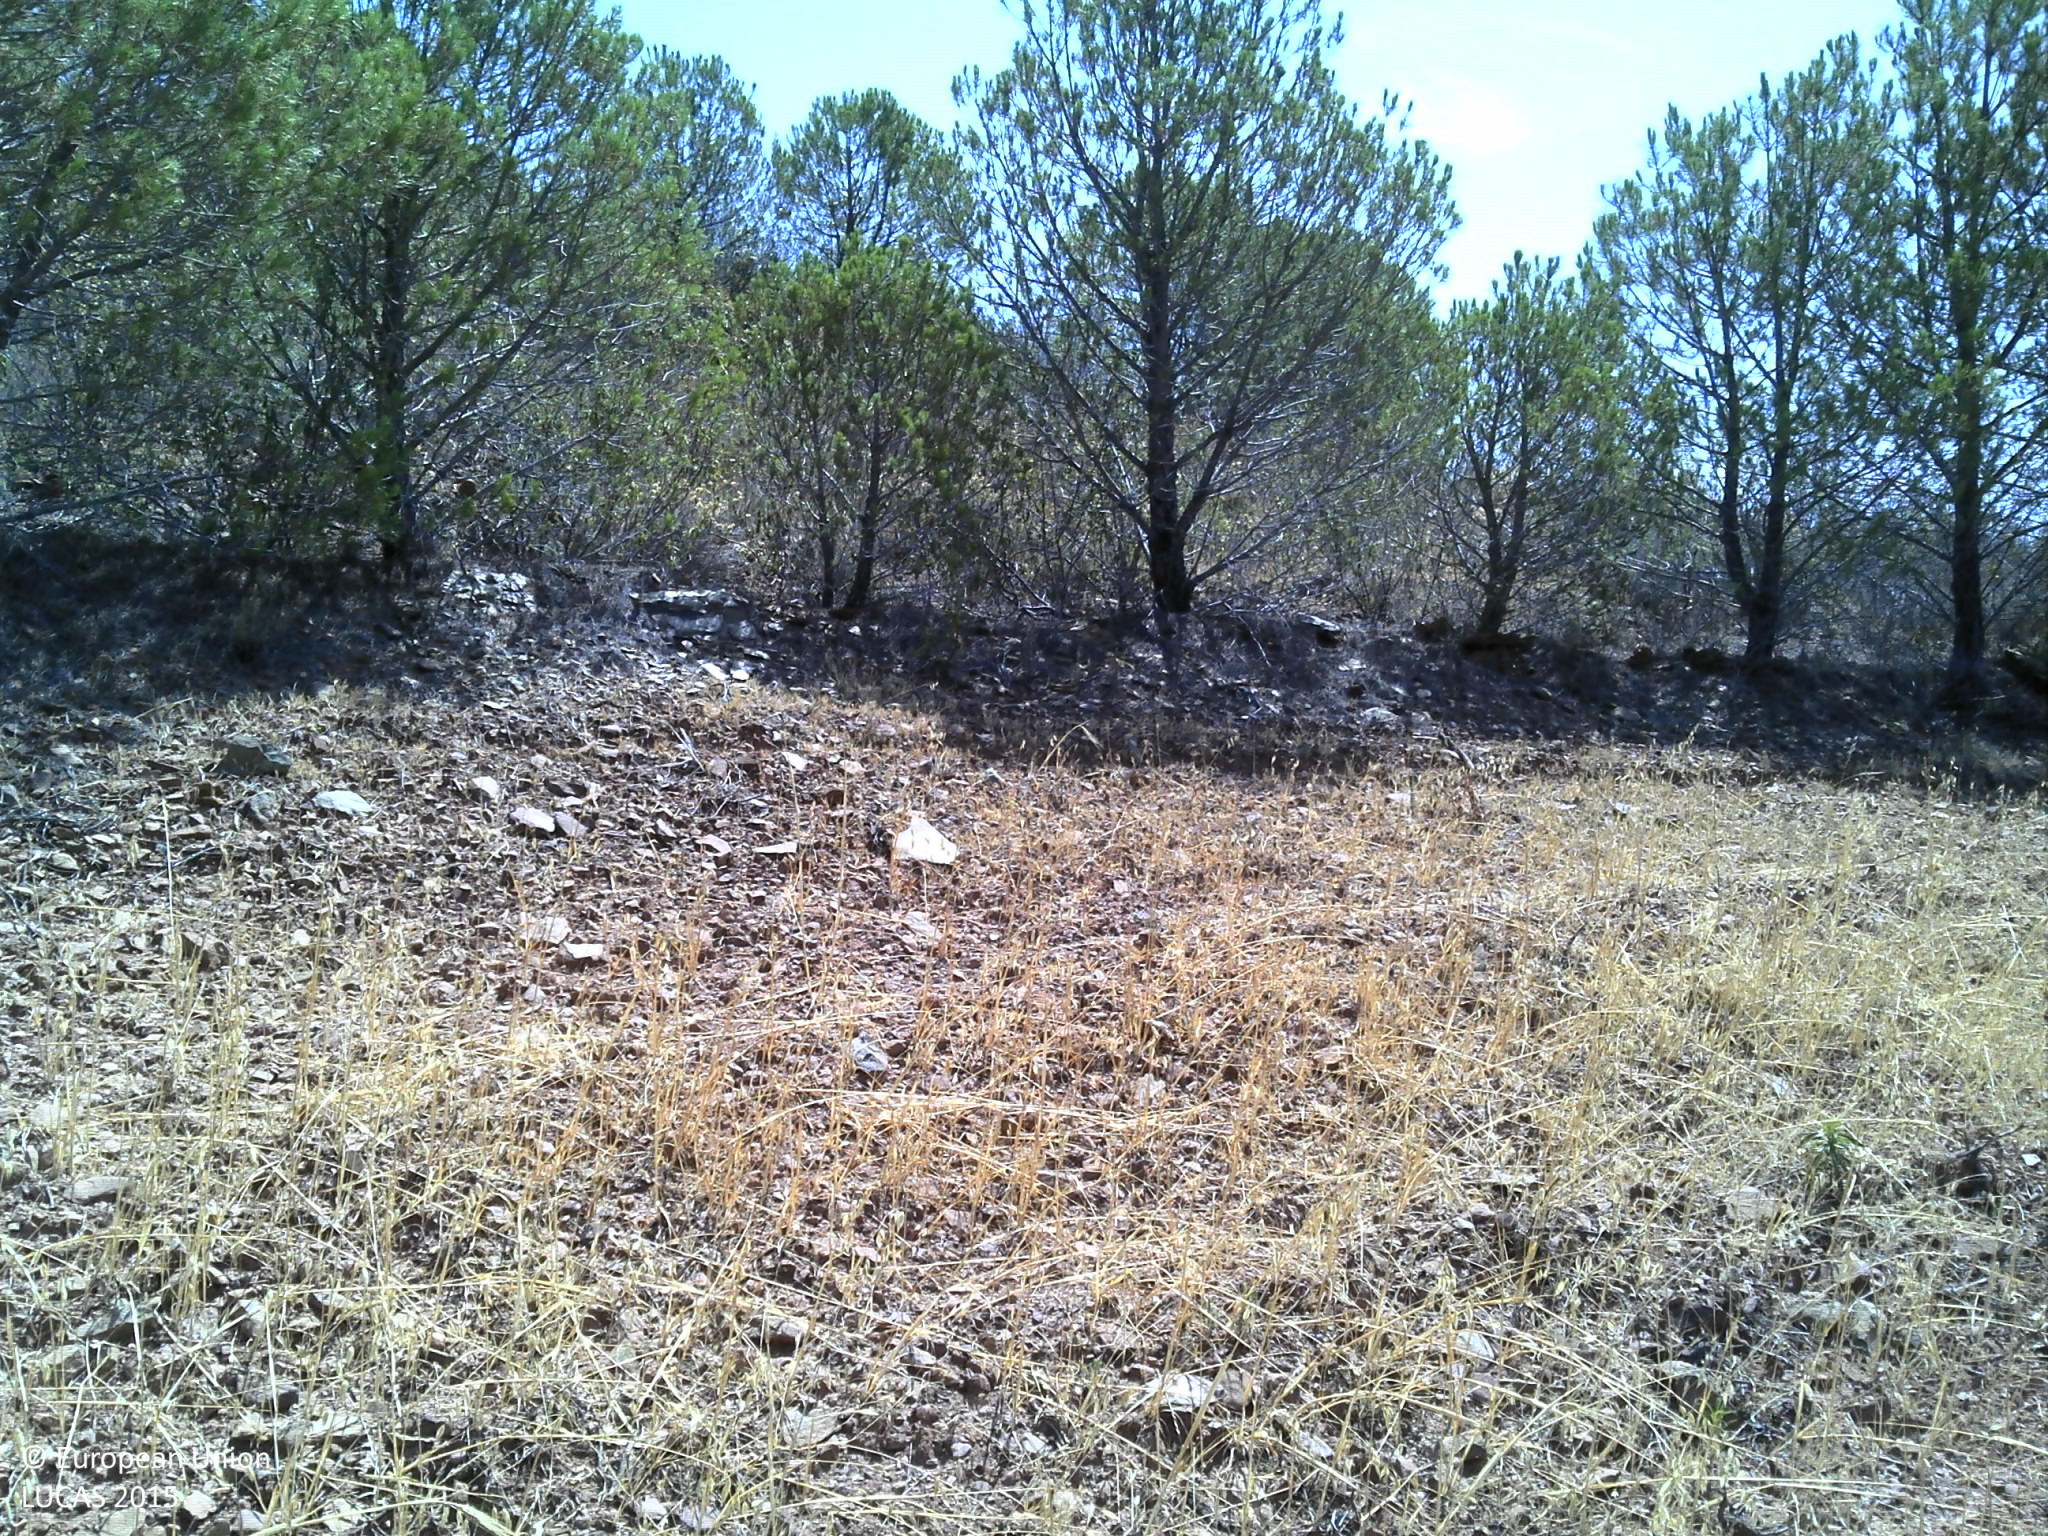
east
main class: Woodland
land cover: Pine dominated coniferous woodland
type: coniferous forest of the mediterranean region
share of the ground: 10 - 25 %
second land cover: Oats
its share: < 10 %
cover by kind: coniferous forest trees 85 %, herbaceous plants 10 %, unconsolidated bare surface 5 %
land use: Forestry
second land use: Agriculture (excluding fallow land and kitchen gardens)
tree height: < 5 m
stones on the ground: < 10 %
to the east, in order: Pine dominated coniferous woodland; Oats; Shrubland without tree cover; Pine dominated coniferous woodland; Shrubland without tree cover; Tracks; Pine dominated coniferous woodland; Shrubland without tree cover; Rivers and streams; Shrubland without tree cover; Single bushes/trees
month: July
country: PT
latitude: 37.4259
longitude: -7.8820
